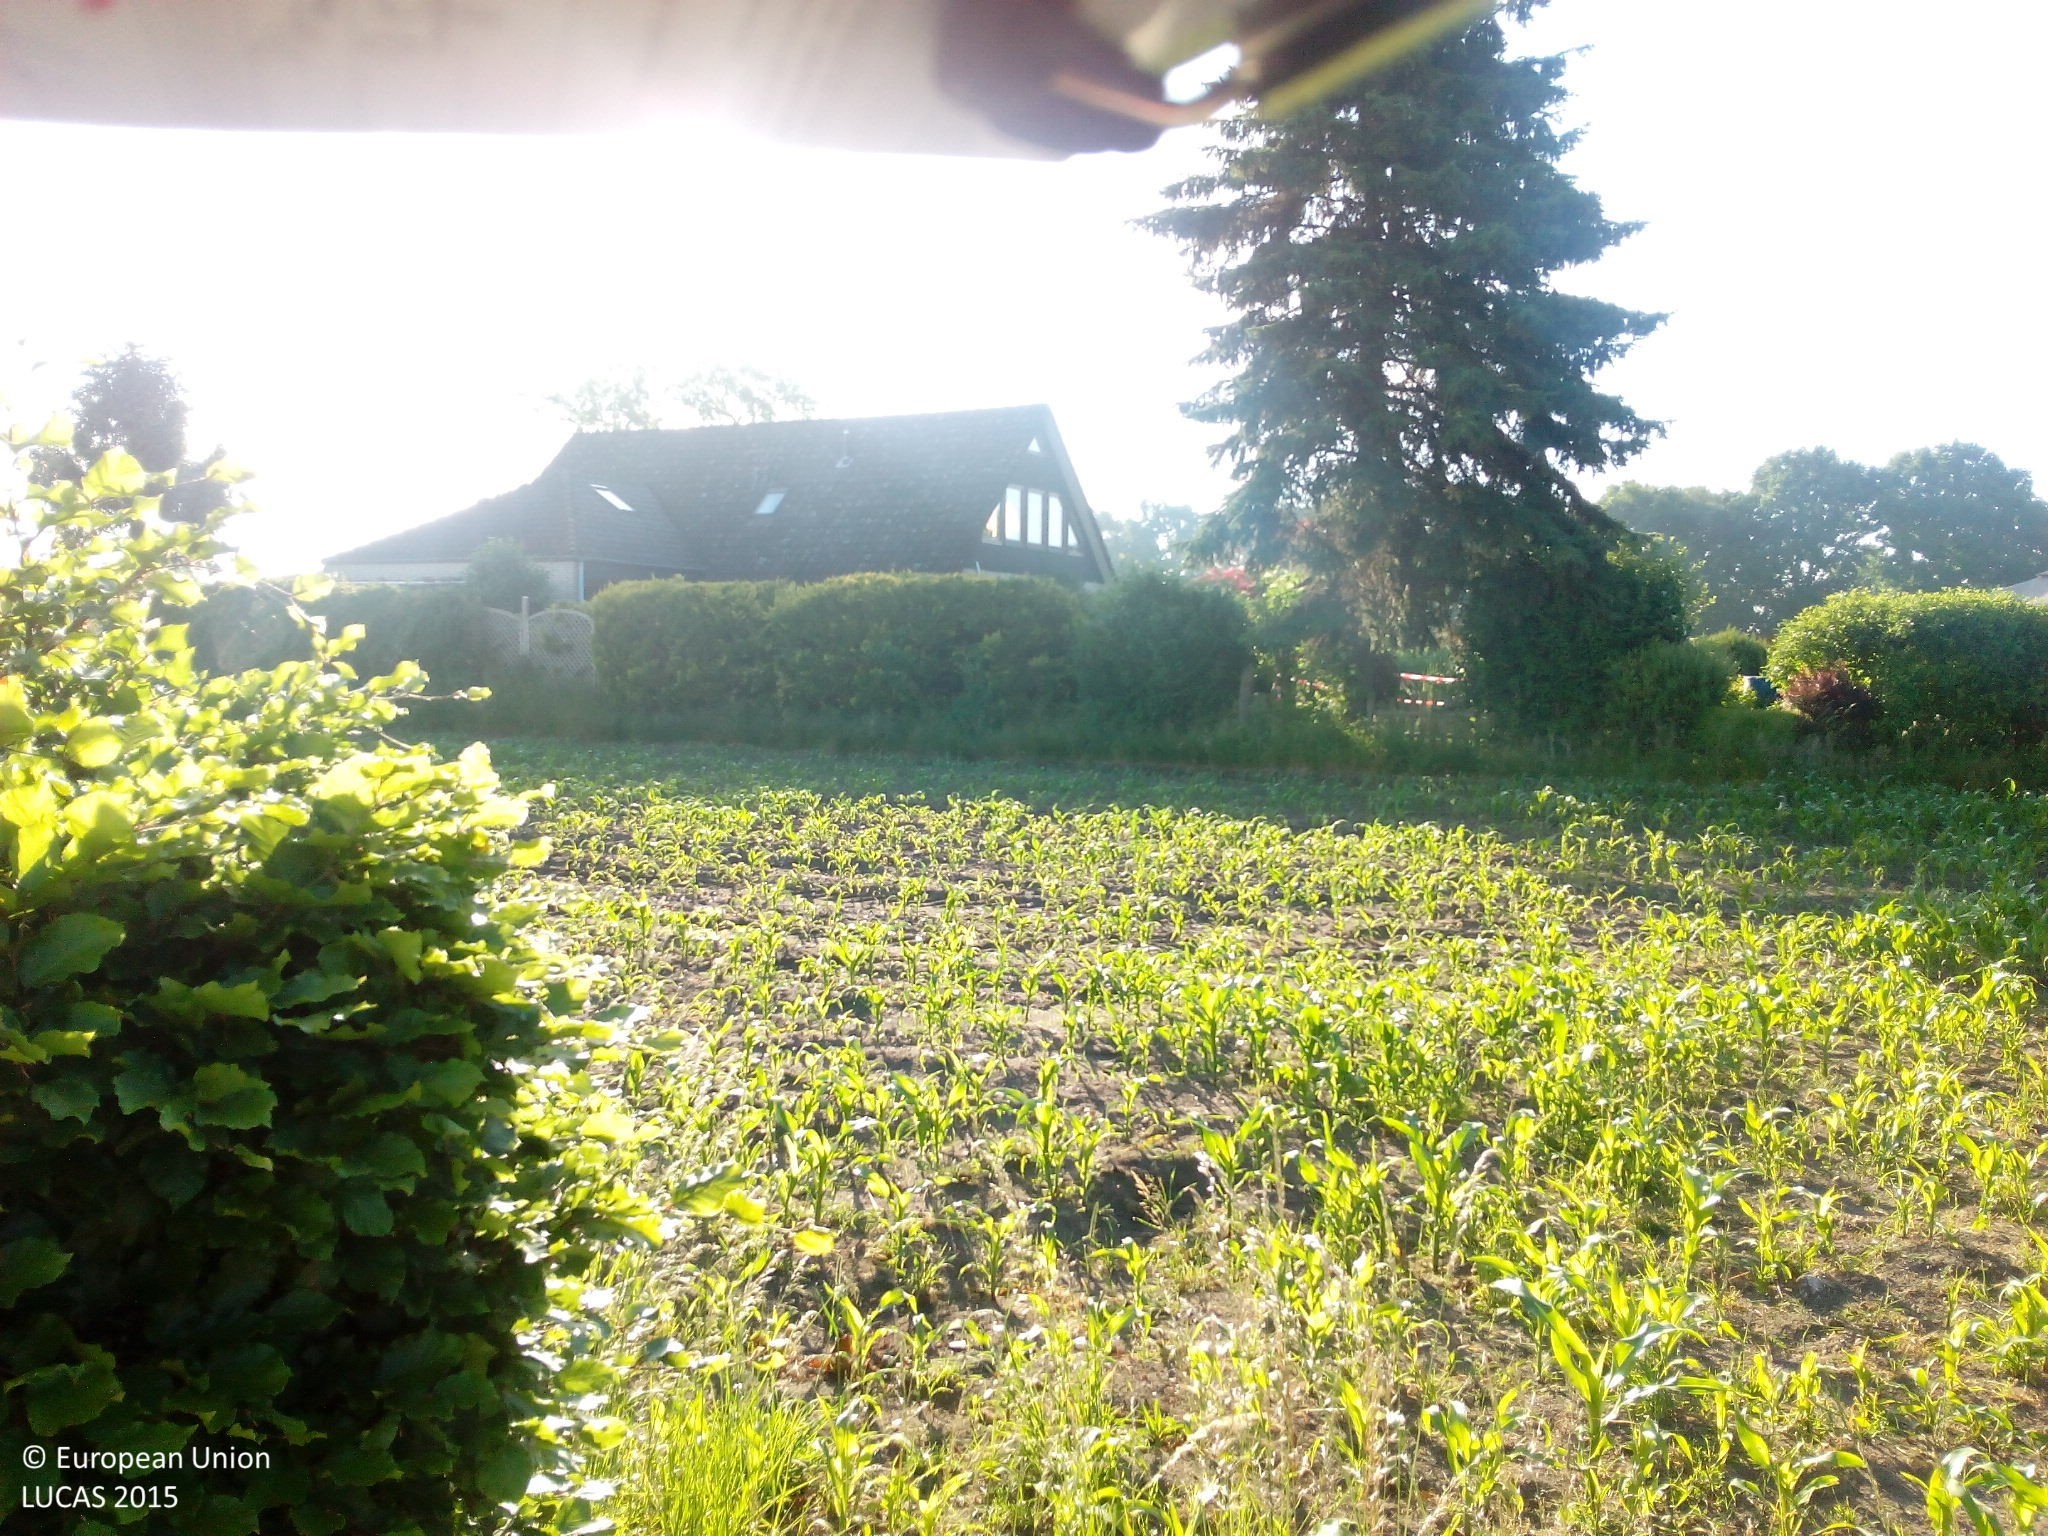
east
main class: Shrubland
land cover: Shrubland with sparse tree cover
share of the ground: > 75 %
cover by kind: herbaceous plants 70 %, shrubs 25 %, broadleaved forest trees 5 %
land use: Residential
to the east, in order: Shrubland with sparse tree cover; Artificial constructions in urban areas; Maize; Artificial constructions in urban areas; Maize; Other bare soil; Lines of trees; Tracks; Lines of trees; Rye
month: June
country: DE
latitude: 53.0750
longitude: 9.0899
